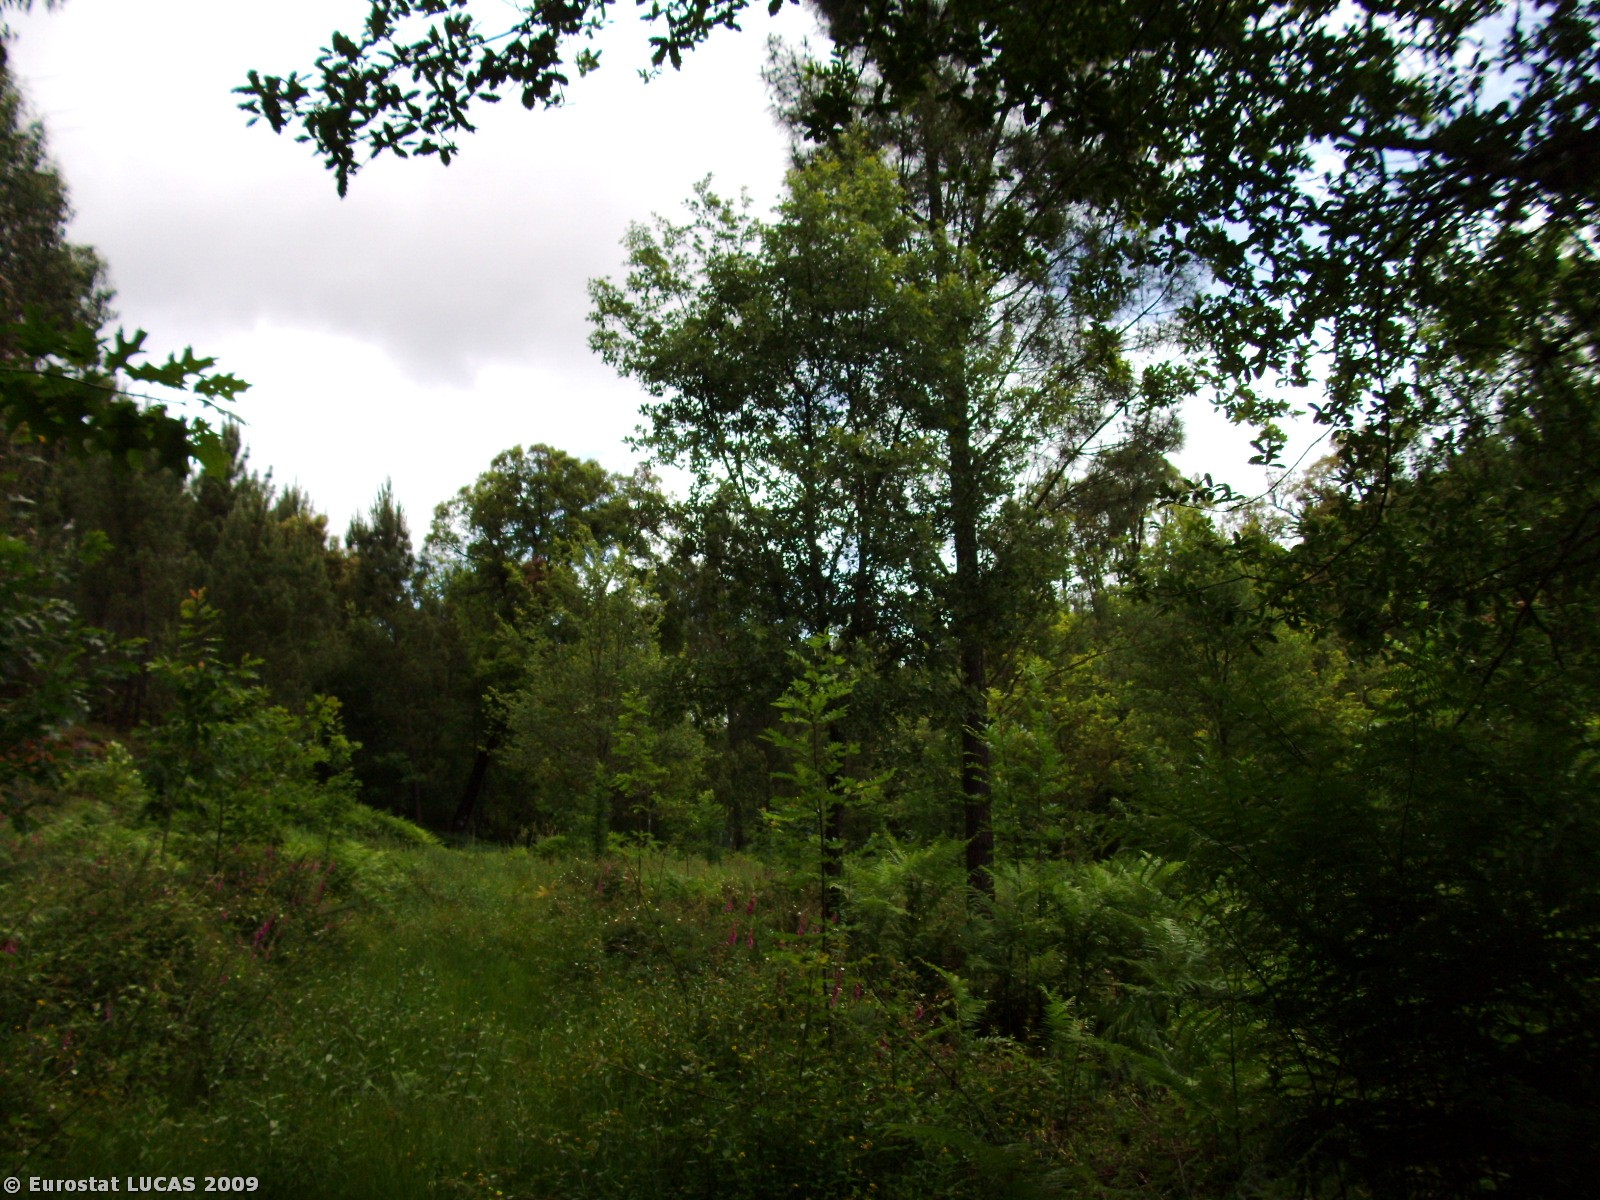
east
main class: Woodland
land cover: Broadleaved woodland
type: mesophytic deciduous forest
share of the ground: 50 - 75 %
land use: Forestry
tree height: > 5 m
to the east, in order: Broadleaved woodland; Tracks; Broadleaved woodland; Electric lines; Broadleaved woodland; Paved roads, cycling and walking lanes; Coniferous woodland; Tracks; Coniferous woodland
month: June
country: PT
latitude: 39.9617
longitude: -8.1586
